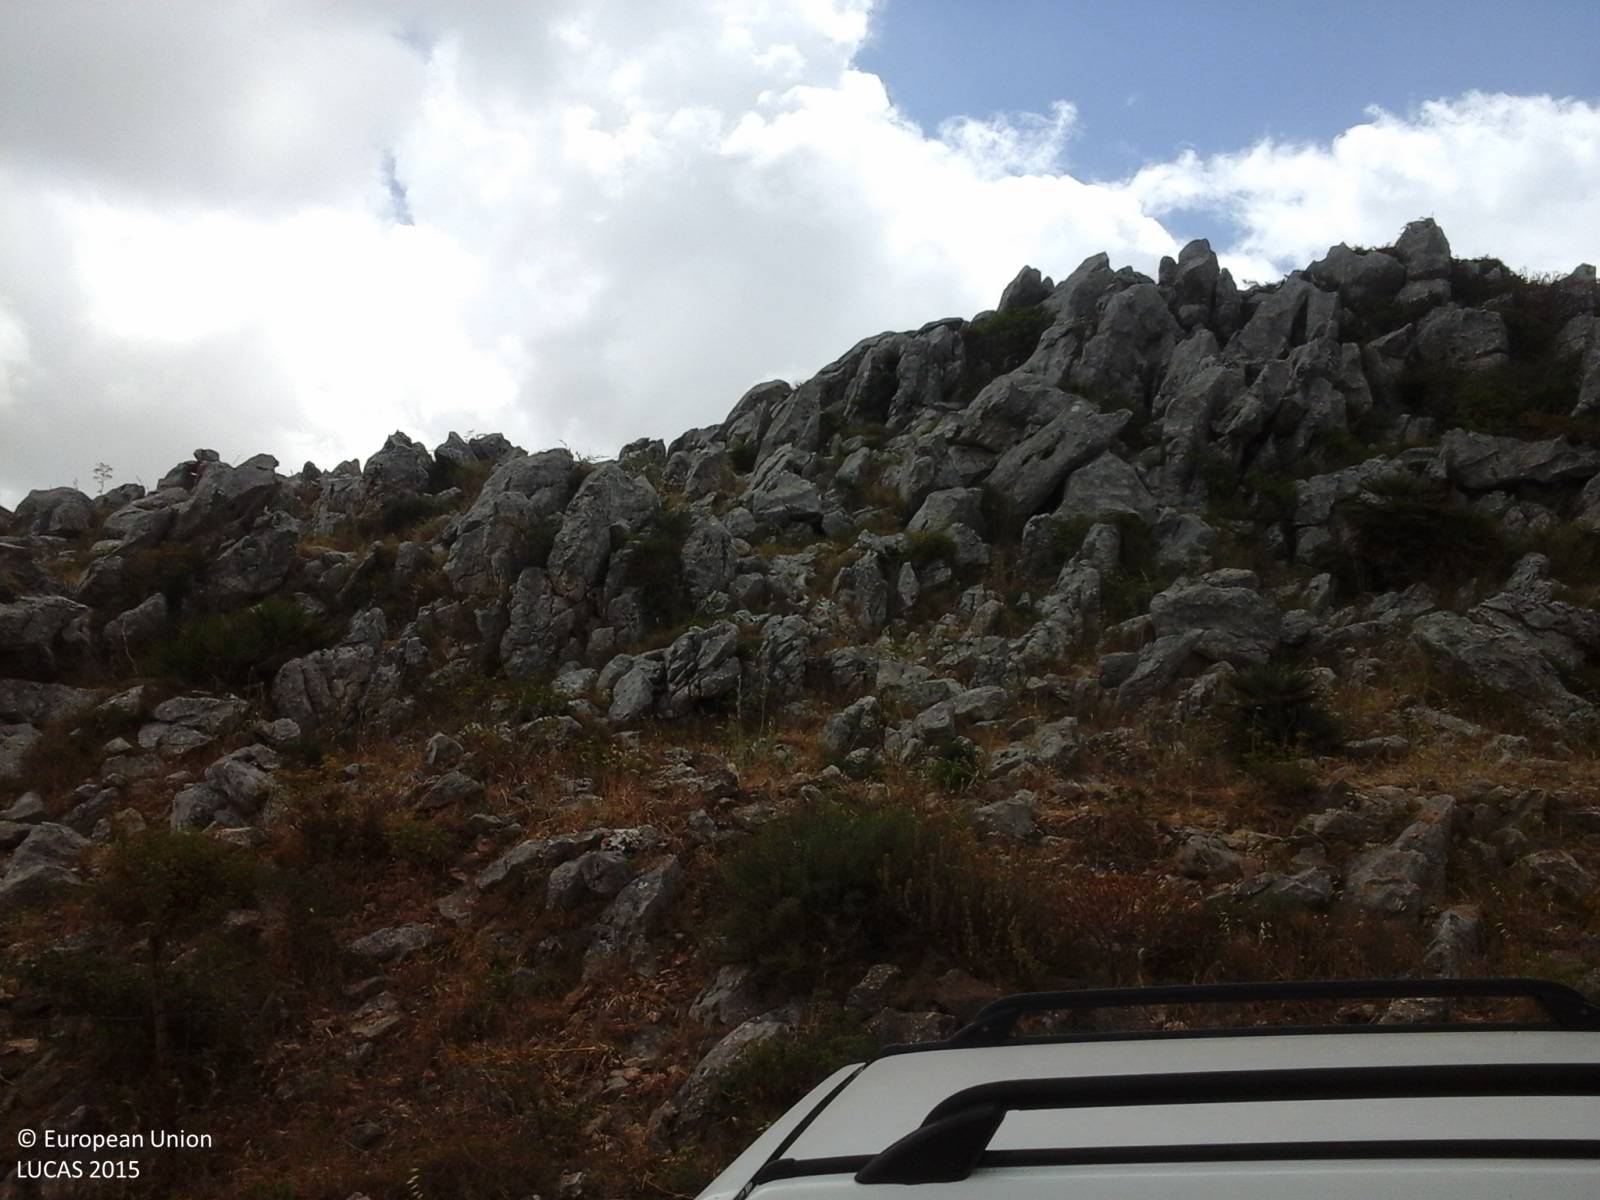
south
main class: Grassland
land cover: Grassland with sparse tree/shrub cover
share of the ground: > 75 %
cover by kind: herbaceous plants 55 %, consolidated bare surface 30 %, shrubs 10 %, coniferous forest trees 5 %
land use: Semi-natural and natural areas not in use
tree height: < 5 m
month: June
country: IT
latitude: 38.0729
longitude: 12.6824
